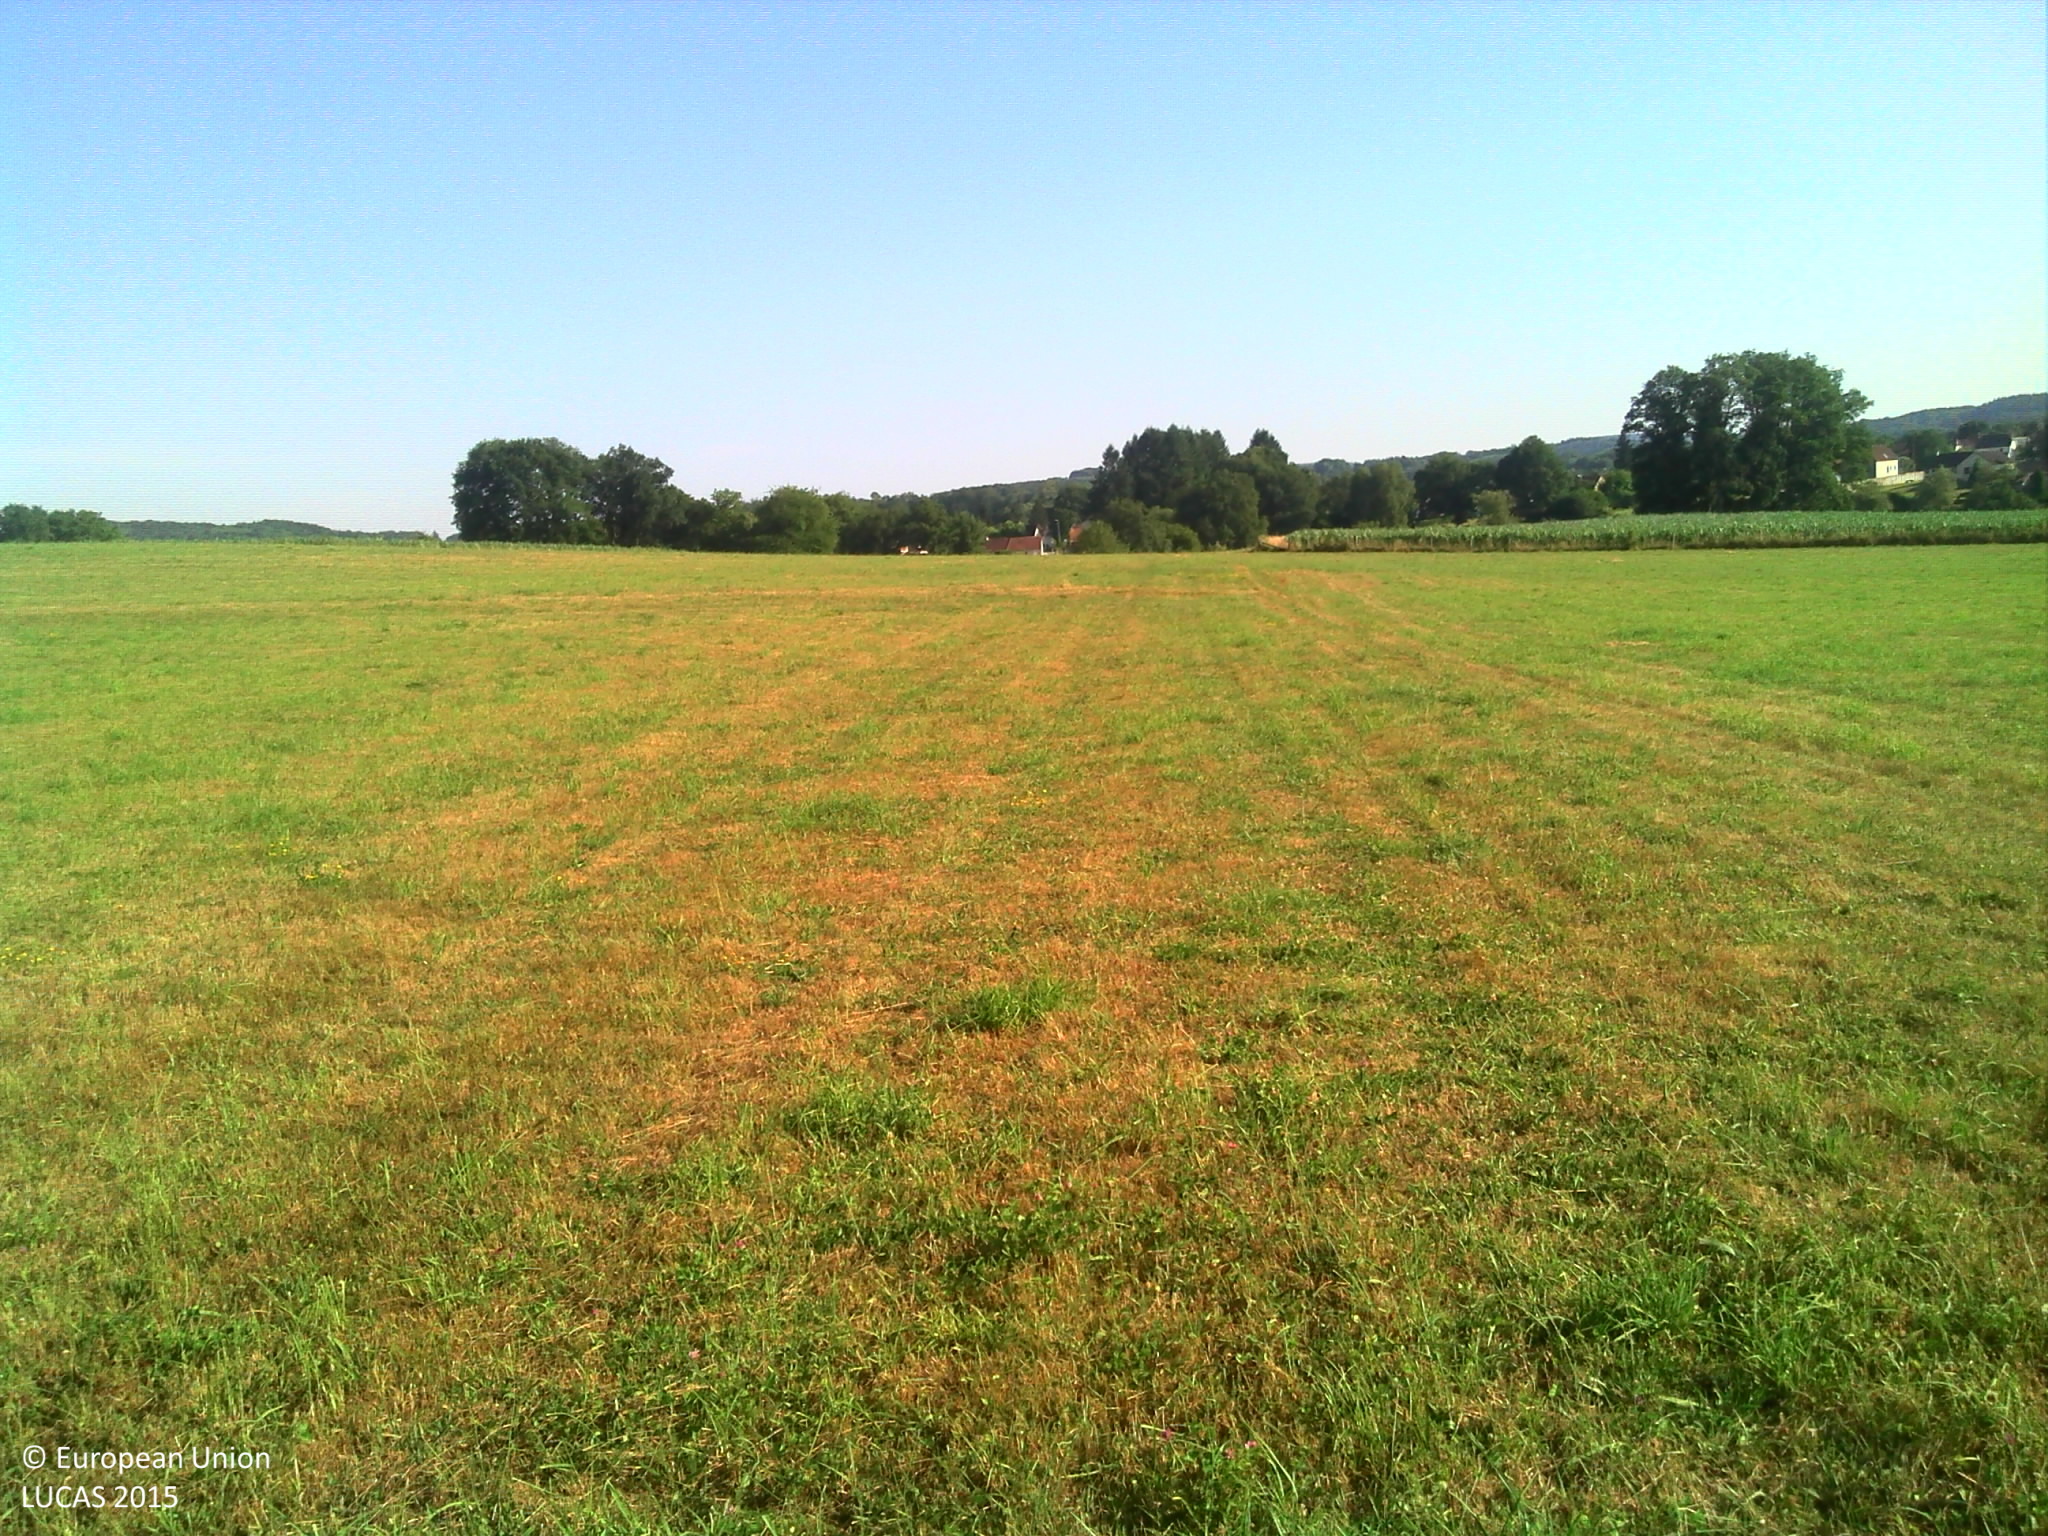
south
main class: Grassland
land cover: Grassland without tree/shrub cover
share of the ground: > 75 %
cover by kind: herbaceous plants 100 %
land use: Agriculture (excluding fallow land and kitchen gardens)
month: July
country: FR
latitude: 46.0987
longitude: 1.6747
